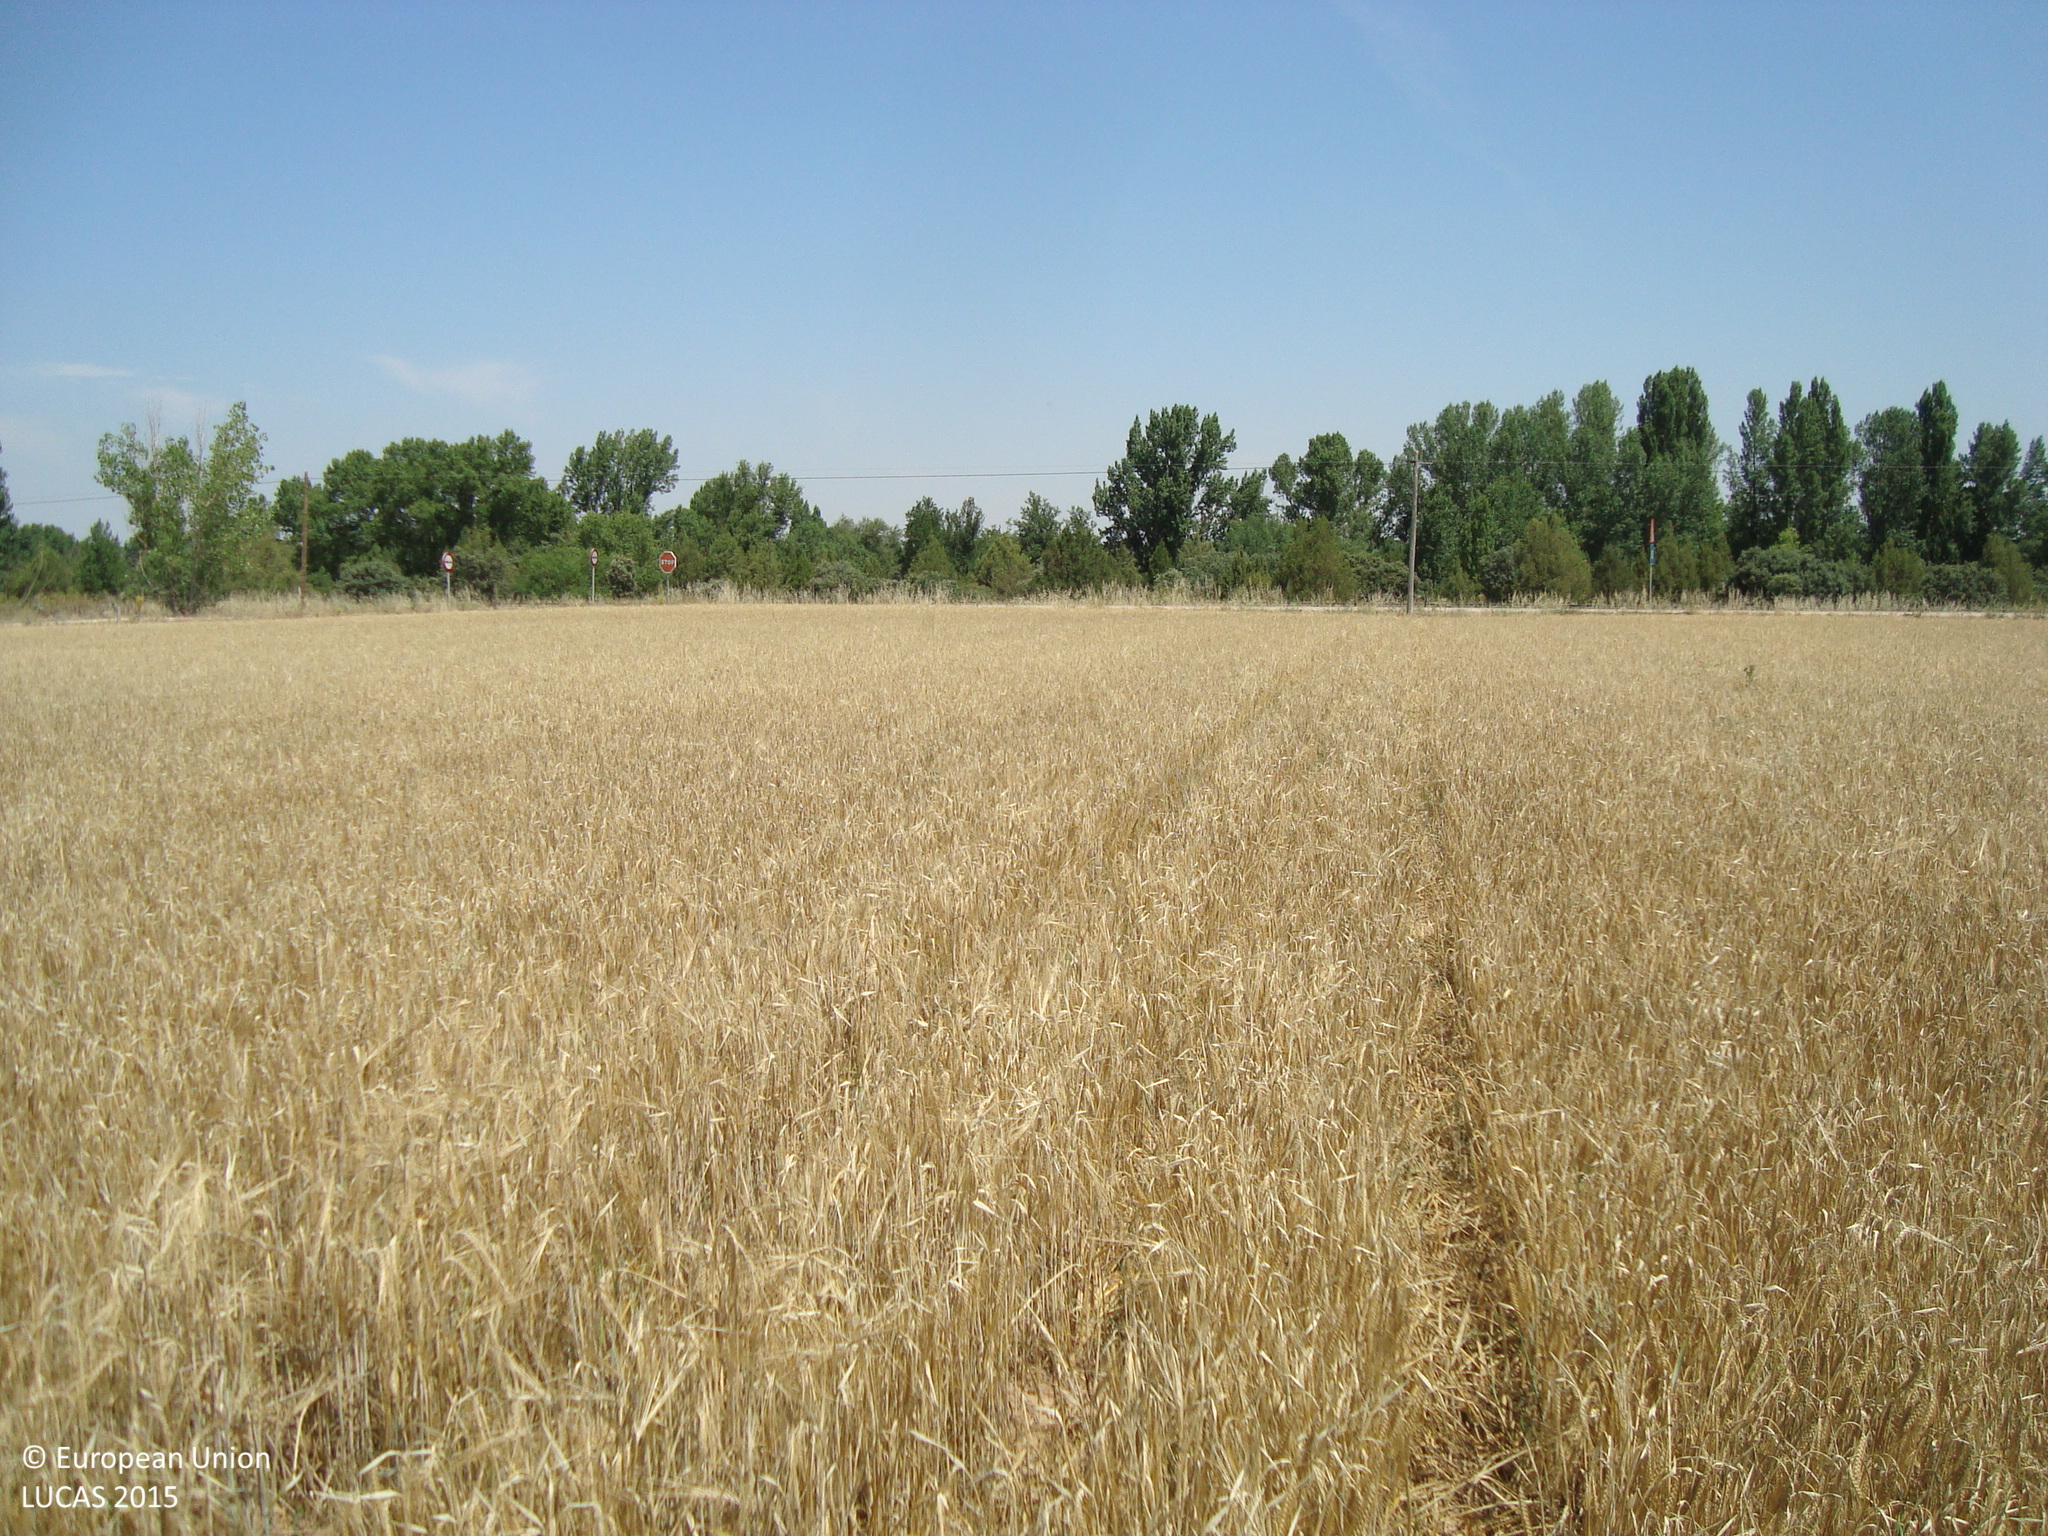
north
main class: Cropland
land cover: Barley
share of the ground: > 75 %
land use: Agriculture (excluding fallow land and kitchen gardens)
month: June
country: ES
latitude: 41.6668
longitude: -3.8063
